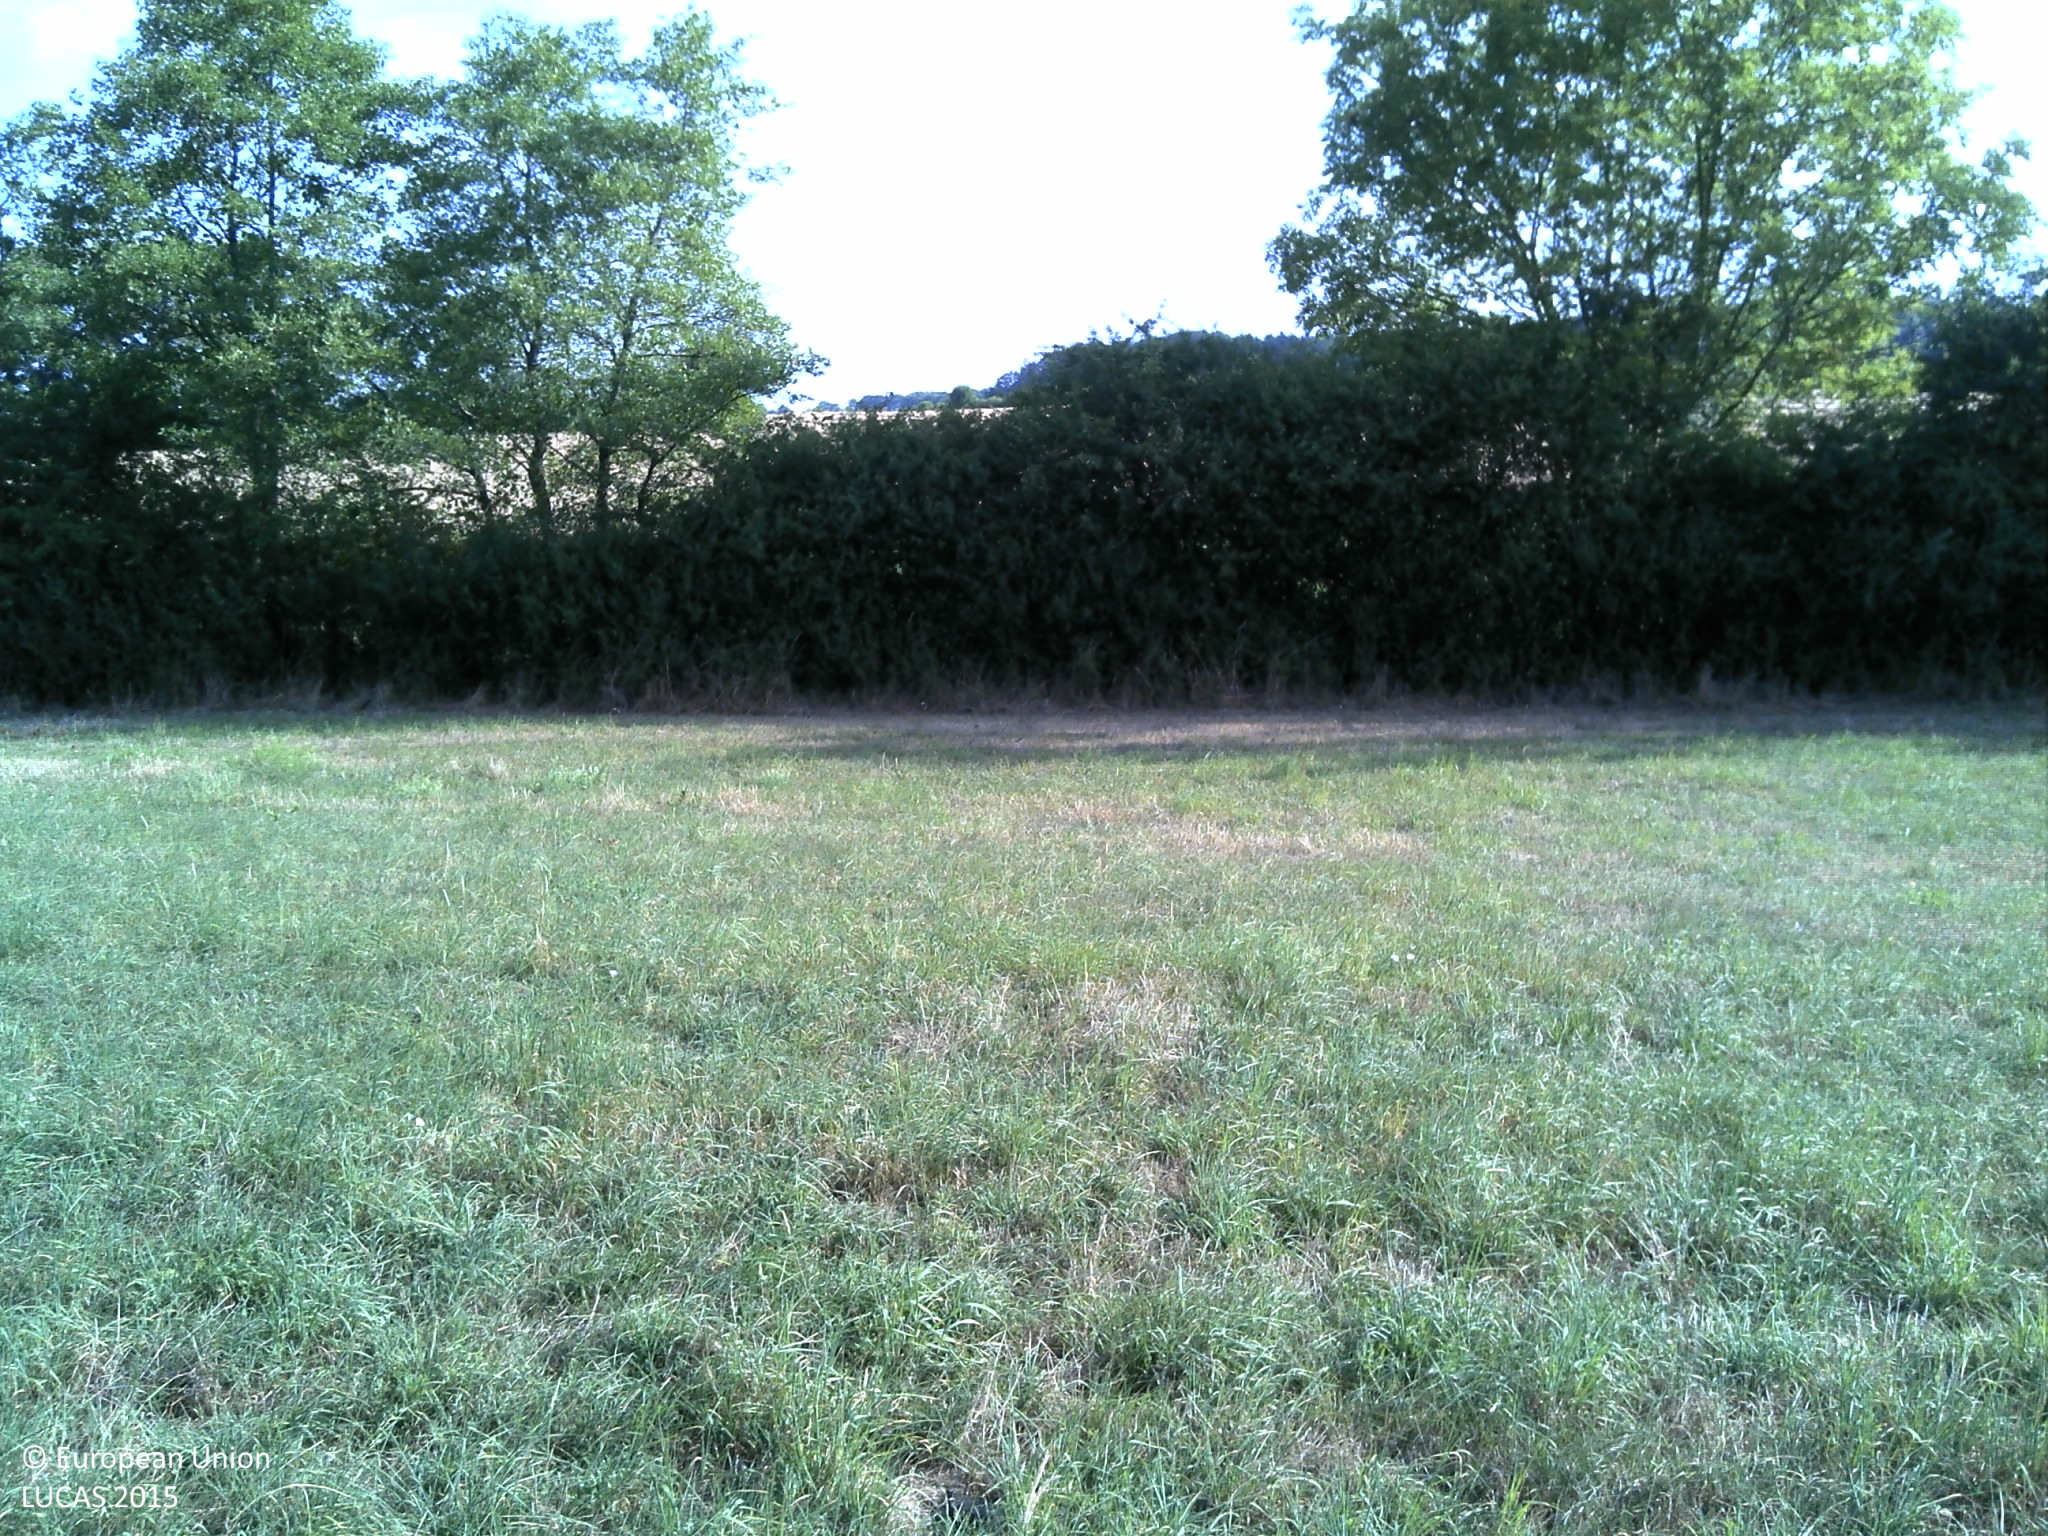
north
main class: Grassland
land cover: Grassland without tree/shrub cover
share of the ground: > 75 %
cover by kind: herbaceous plants 100 %
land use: Agriculture (excluding fallow land and kitchen gardens)
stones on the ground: 10 - 25 %
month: July
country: FR
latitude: 48.1796
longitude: 6.3021
